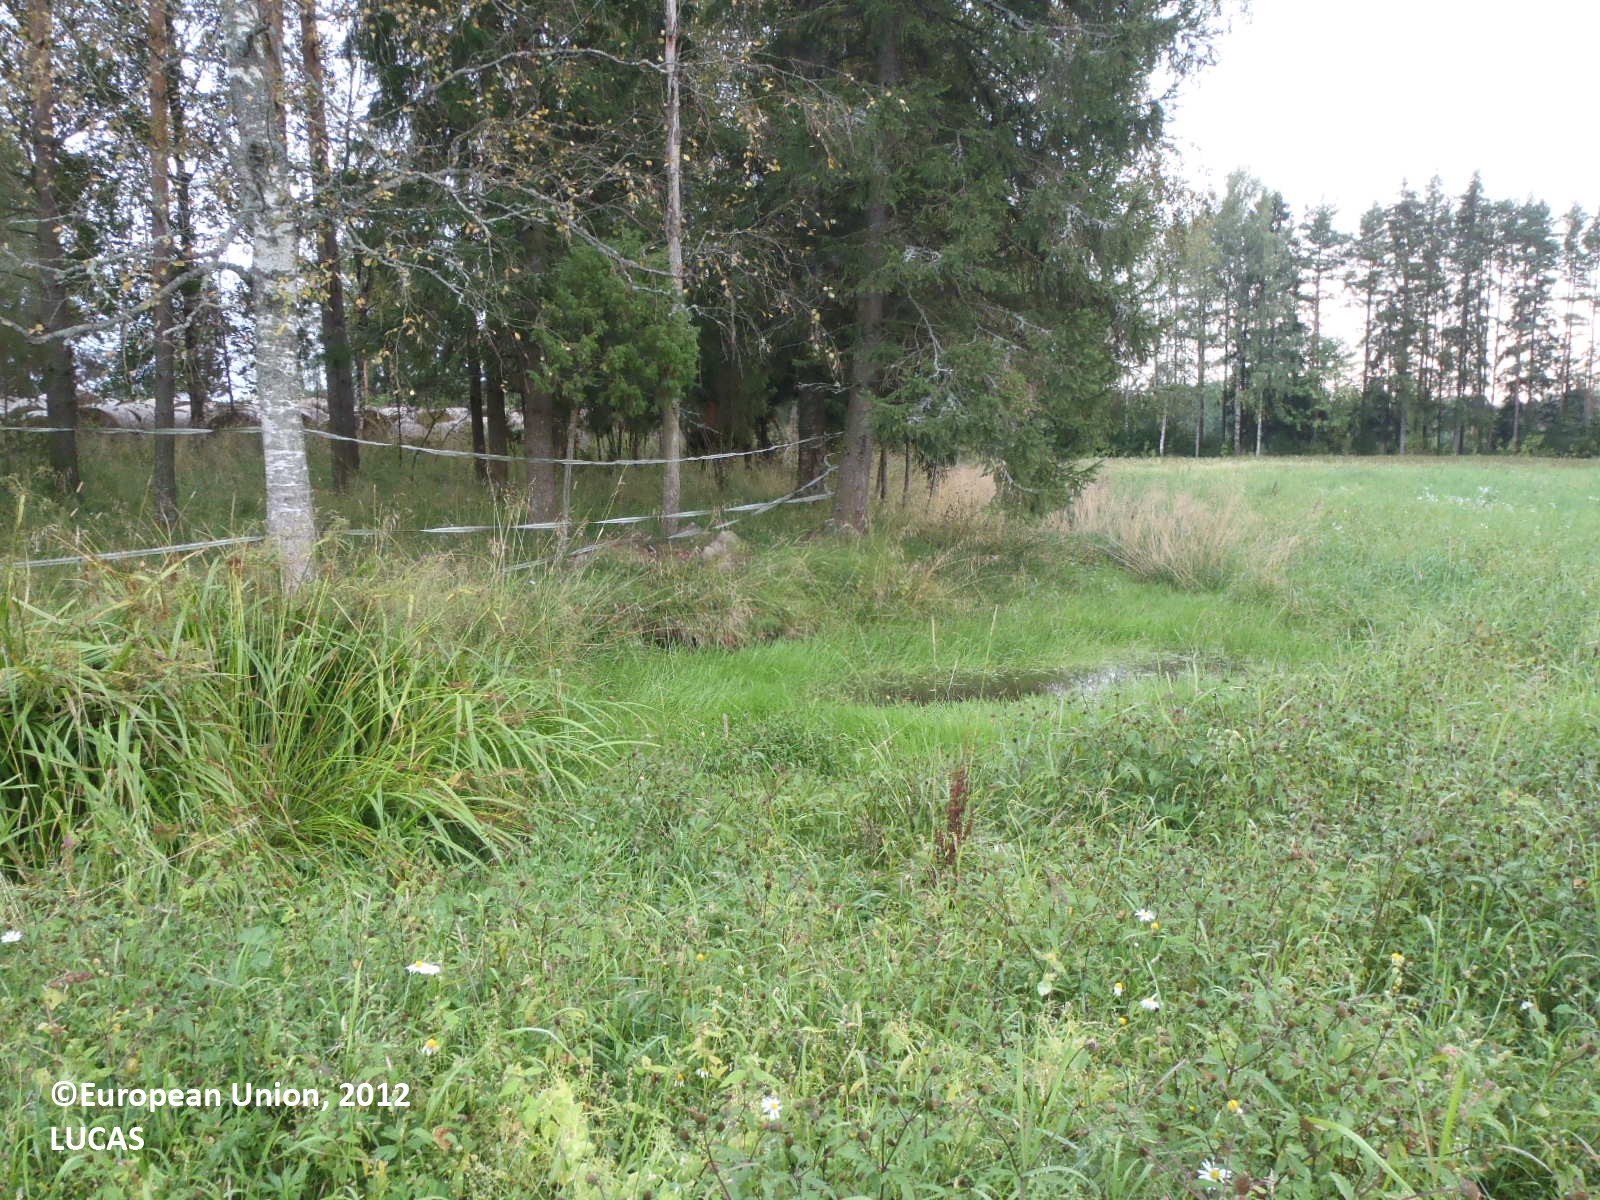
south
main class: Cropland
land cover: Mixed cereals for fodder
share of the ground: > 75 %
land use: Agriculture (excluding fallow land and kitchen gardens)
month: August
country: FI
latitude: 60.9205
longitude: 22.4805
